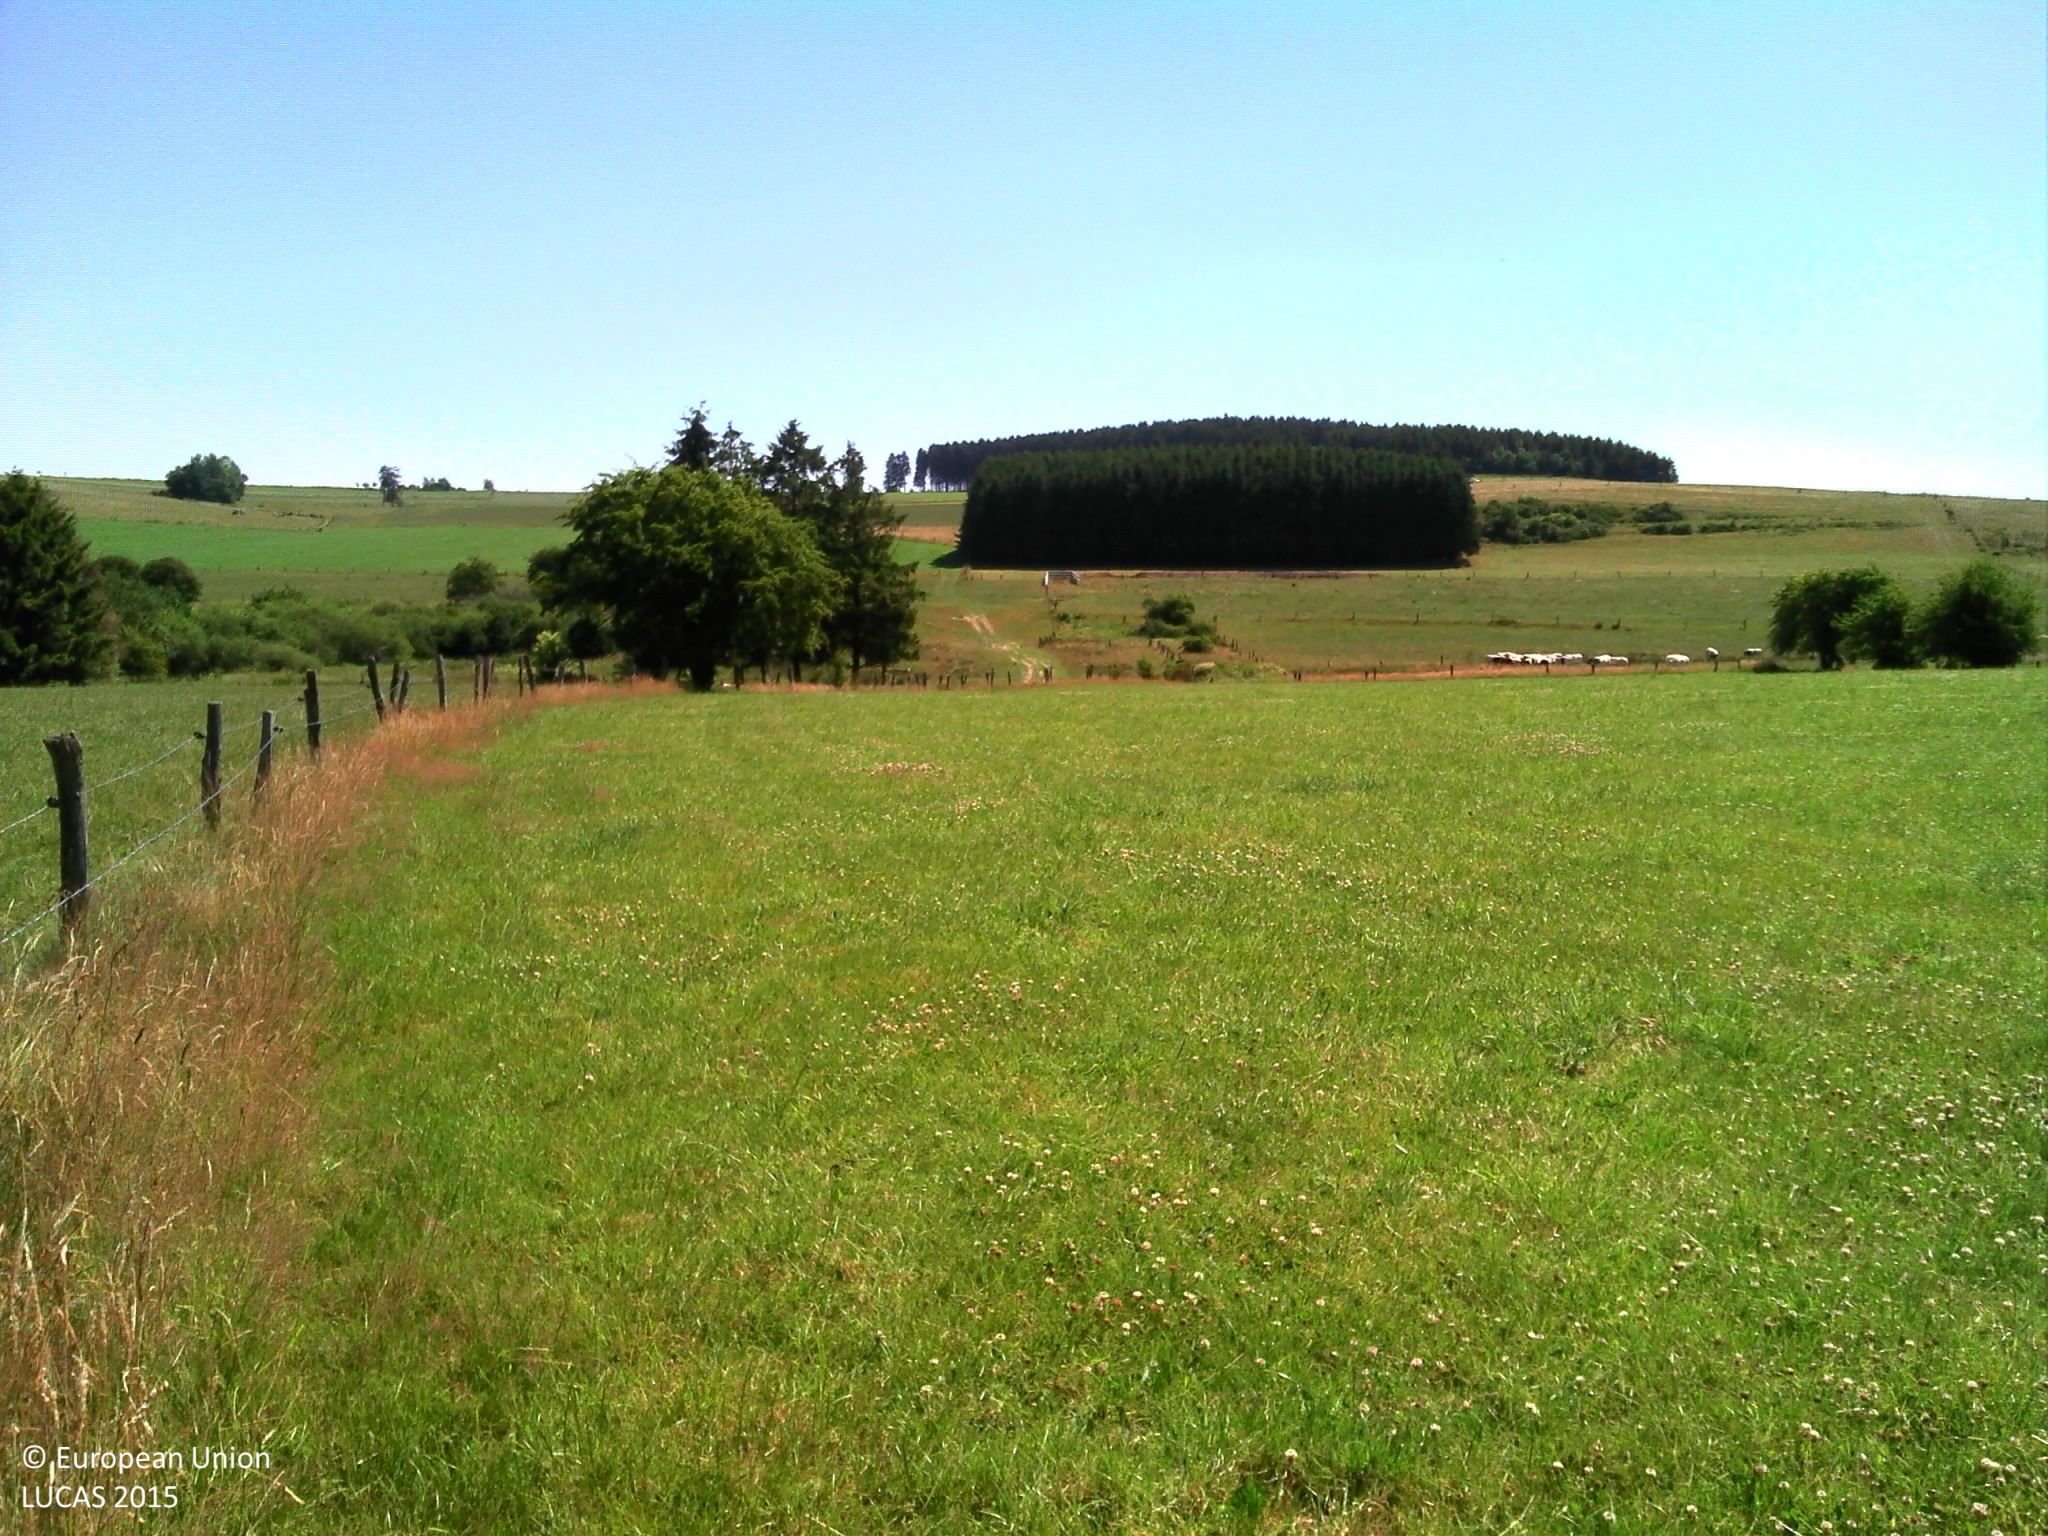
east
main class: Grassland
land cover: Grassland without tree/shrub cover
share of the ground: > 75 %
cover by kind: herbaceous plants 100 %
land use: Agriculture (excluding fallow land and kitchen gardens)
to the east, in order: Grassland without tree/shrub cover; Fences; Spontaneously vegetated surfaces; Rivers and streams; Inland marshes; Broadleaved woodland; Fences; Grassland without tree/shrub cover
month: July
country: BE
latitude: 50.0844
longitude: 5.6801
